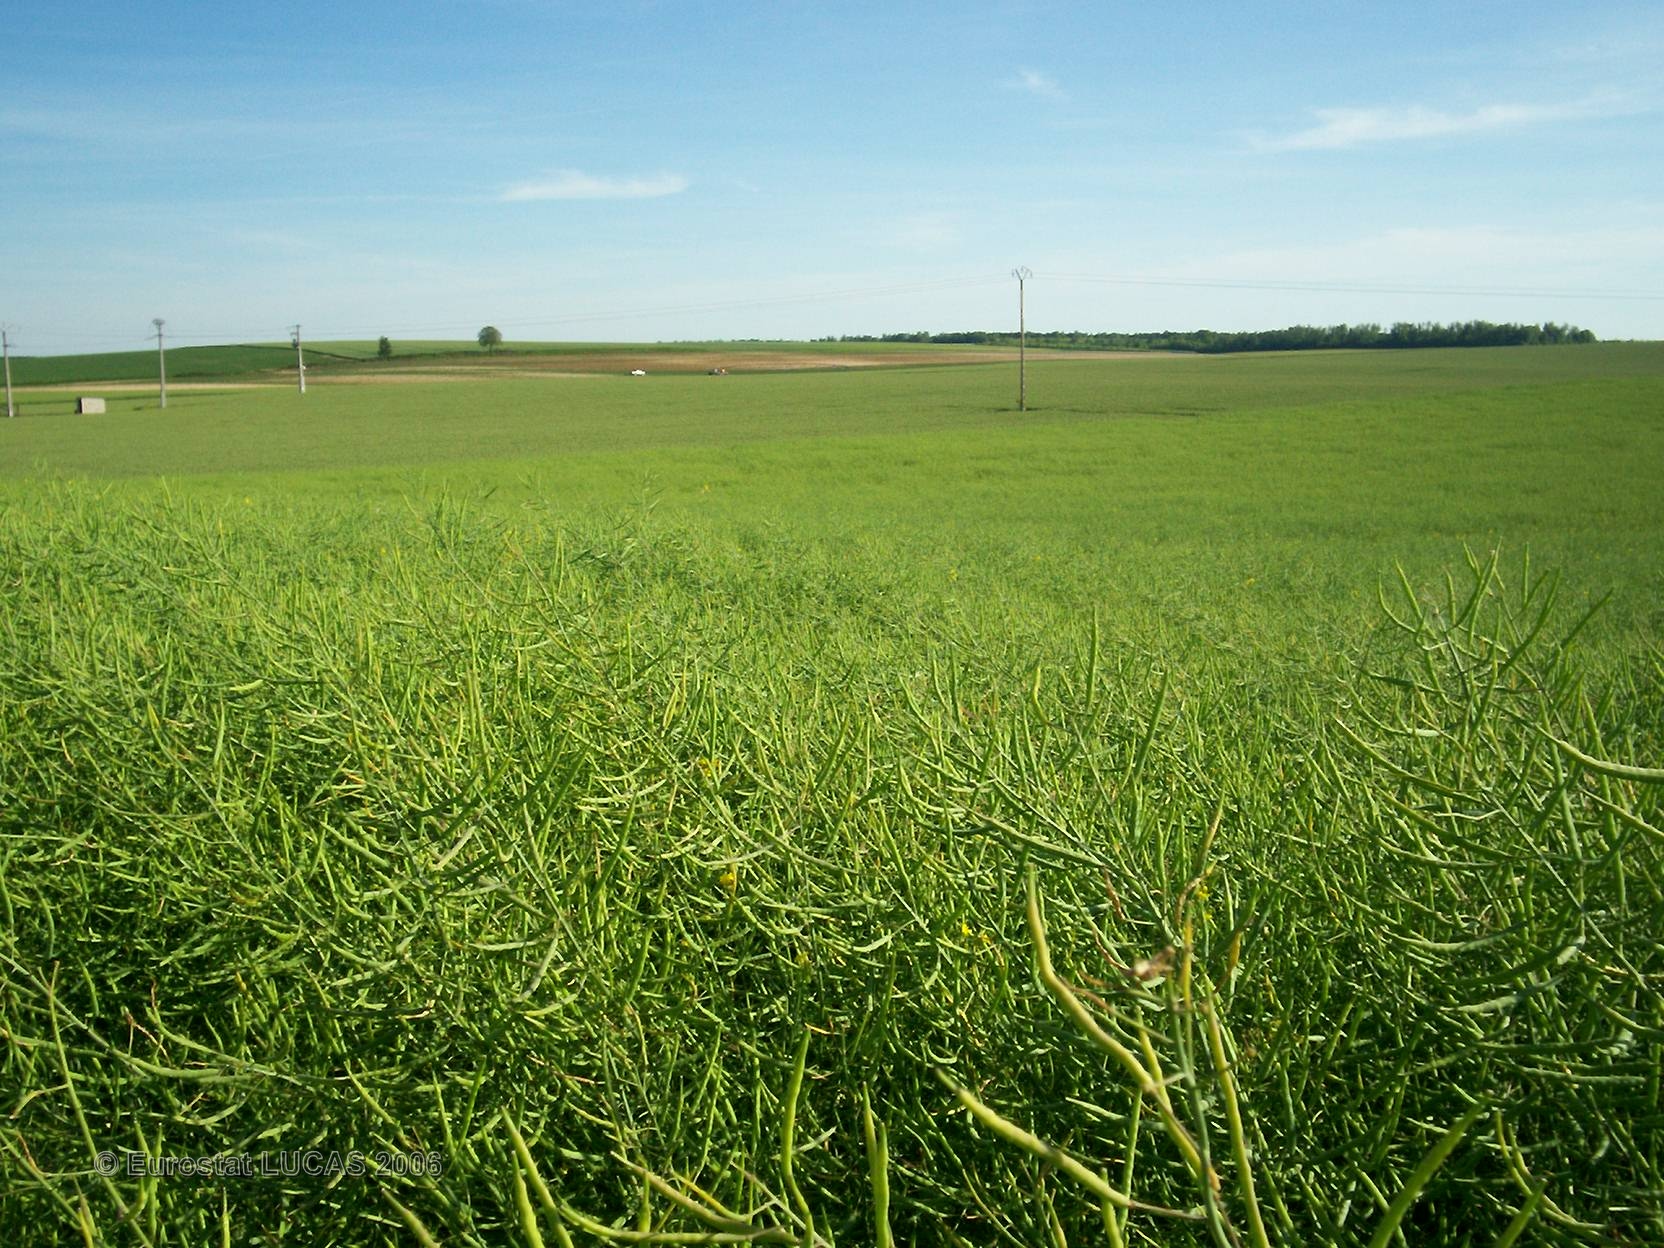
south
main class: Cropland
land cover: Rape and turnip rape
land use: Agriculture (excluding fallow land and kitchen gardens)
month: June
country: FR
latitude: 48.9748
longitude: 4.6005
